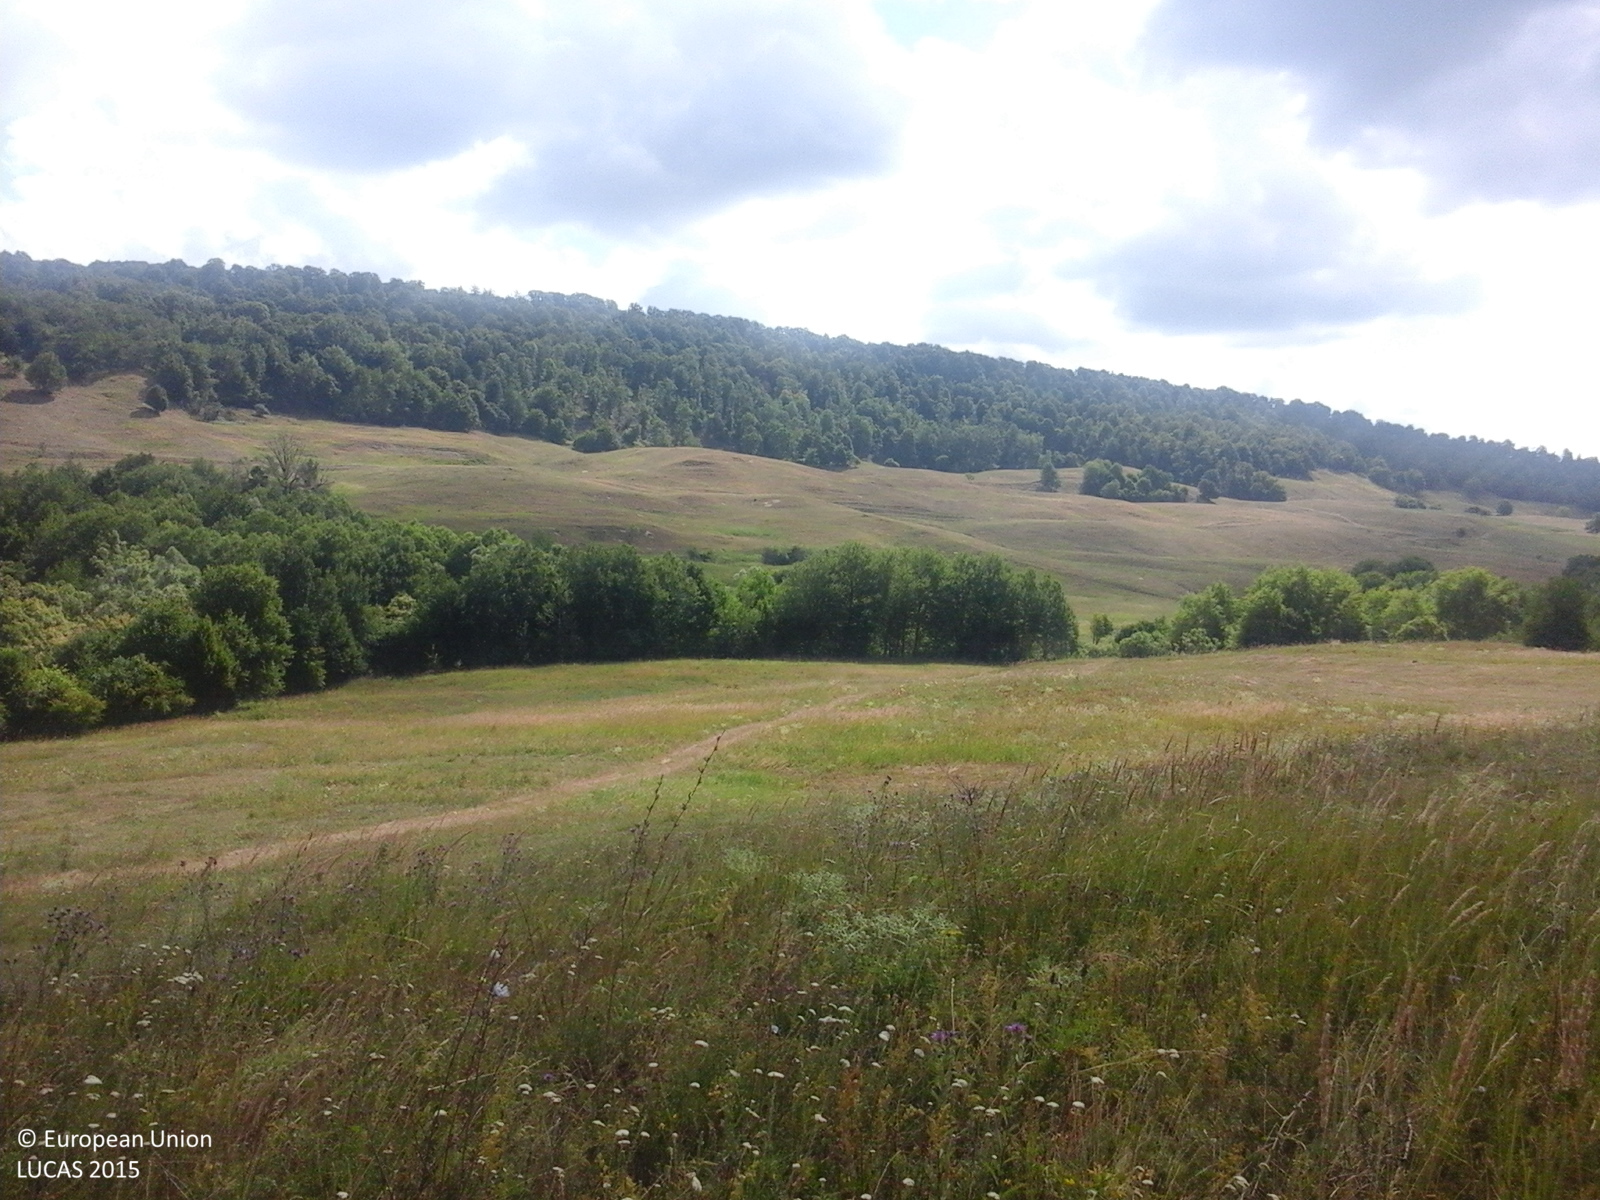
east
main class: Grassland
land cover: Spontaneously vegetated surfaces
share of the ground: > 75 %
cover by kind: herbaceous plants 100 %
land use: Semi-natural and natural areas not in use
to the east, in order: Spontaneously vegetated surfaces; Grassland without tree/shrub cover; Tracks; Grassland without tree/shrub cover; Tracks; Spontaneously vegetated surfaces; Broadleaved woodland
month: July
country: RO
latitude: 46.6542
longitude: 27.2081
